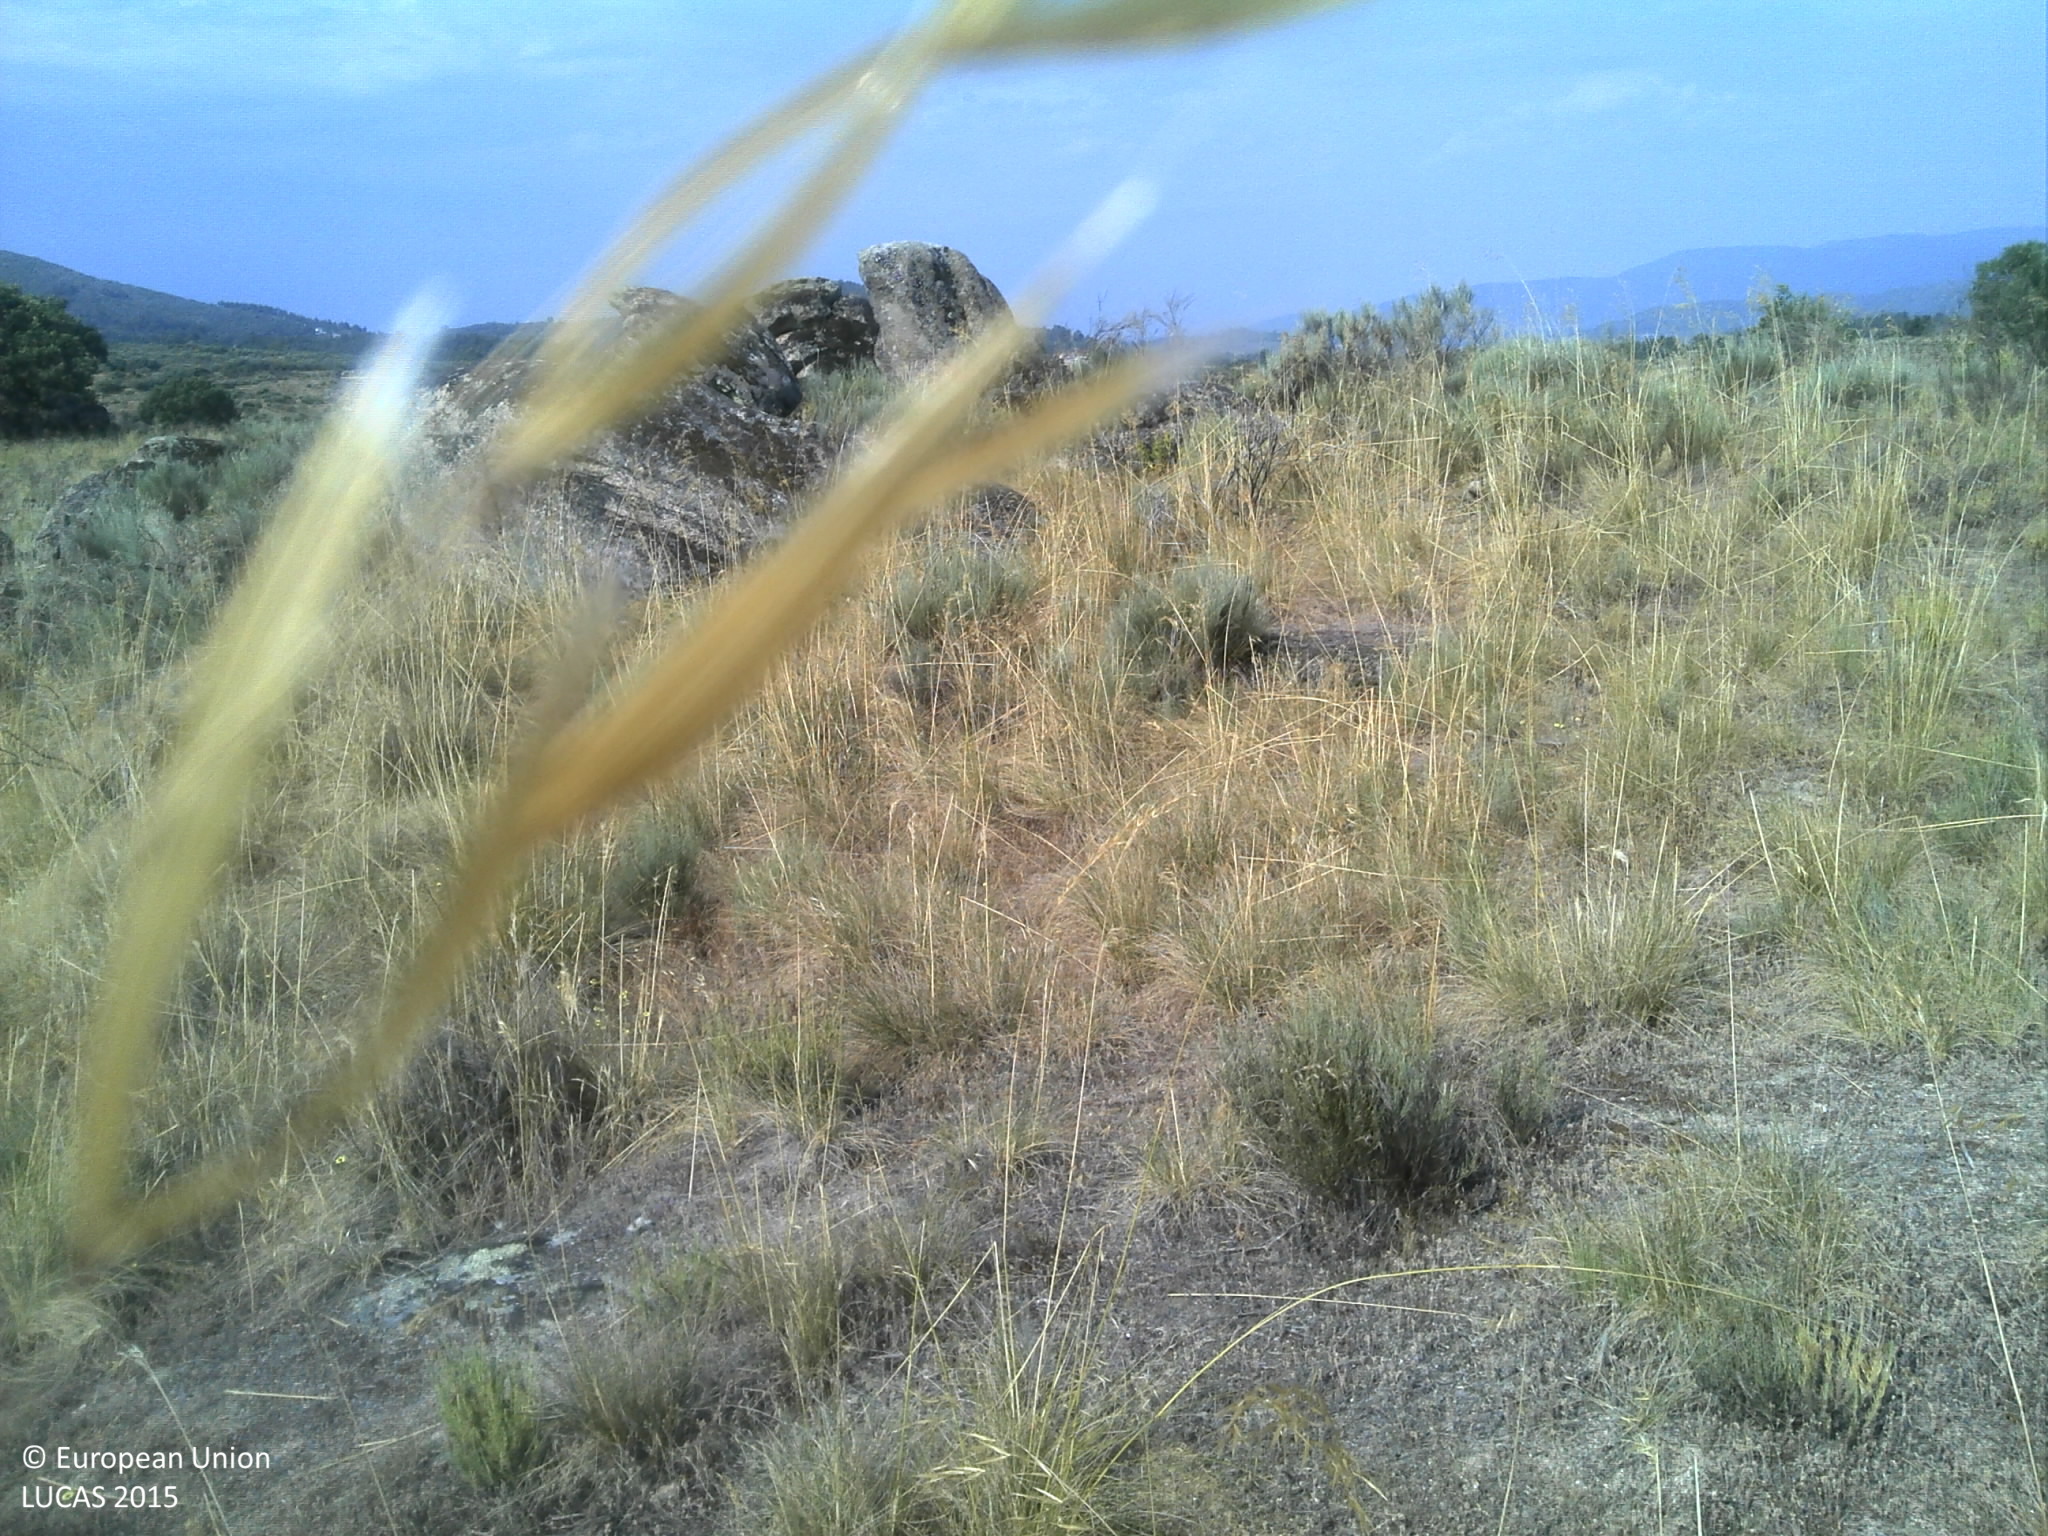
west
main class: Grassland
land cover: Grassland without tree/shrub cover
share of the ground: 50 - 75 %
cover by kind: herbaceous plants 60 %, unconsolidated bare surface 40 %
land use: Agriculture (excluding fallow land and kitchen gardens)
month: June
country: PT
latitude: 40.3486
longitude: -7.2562
